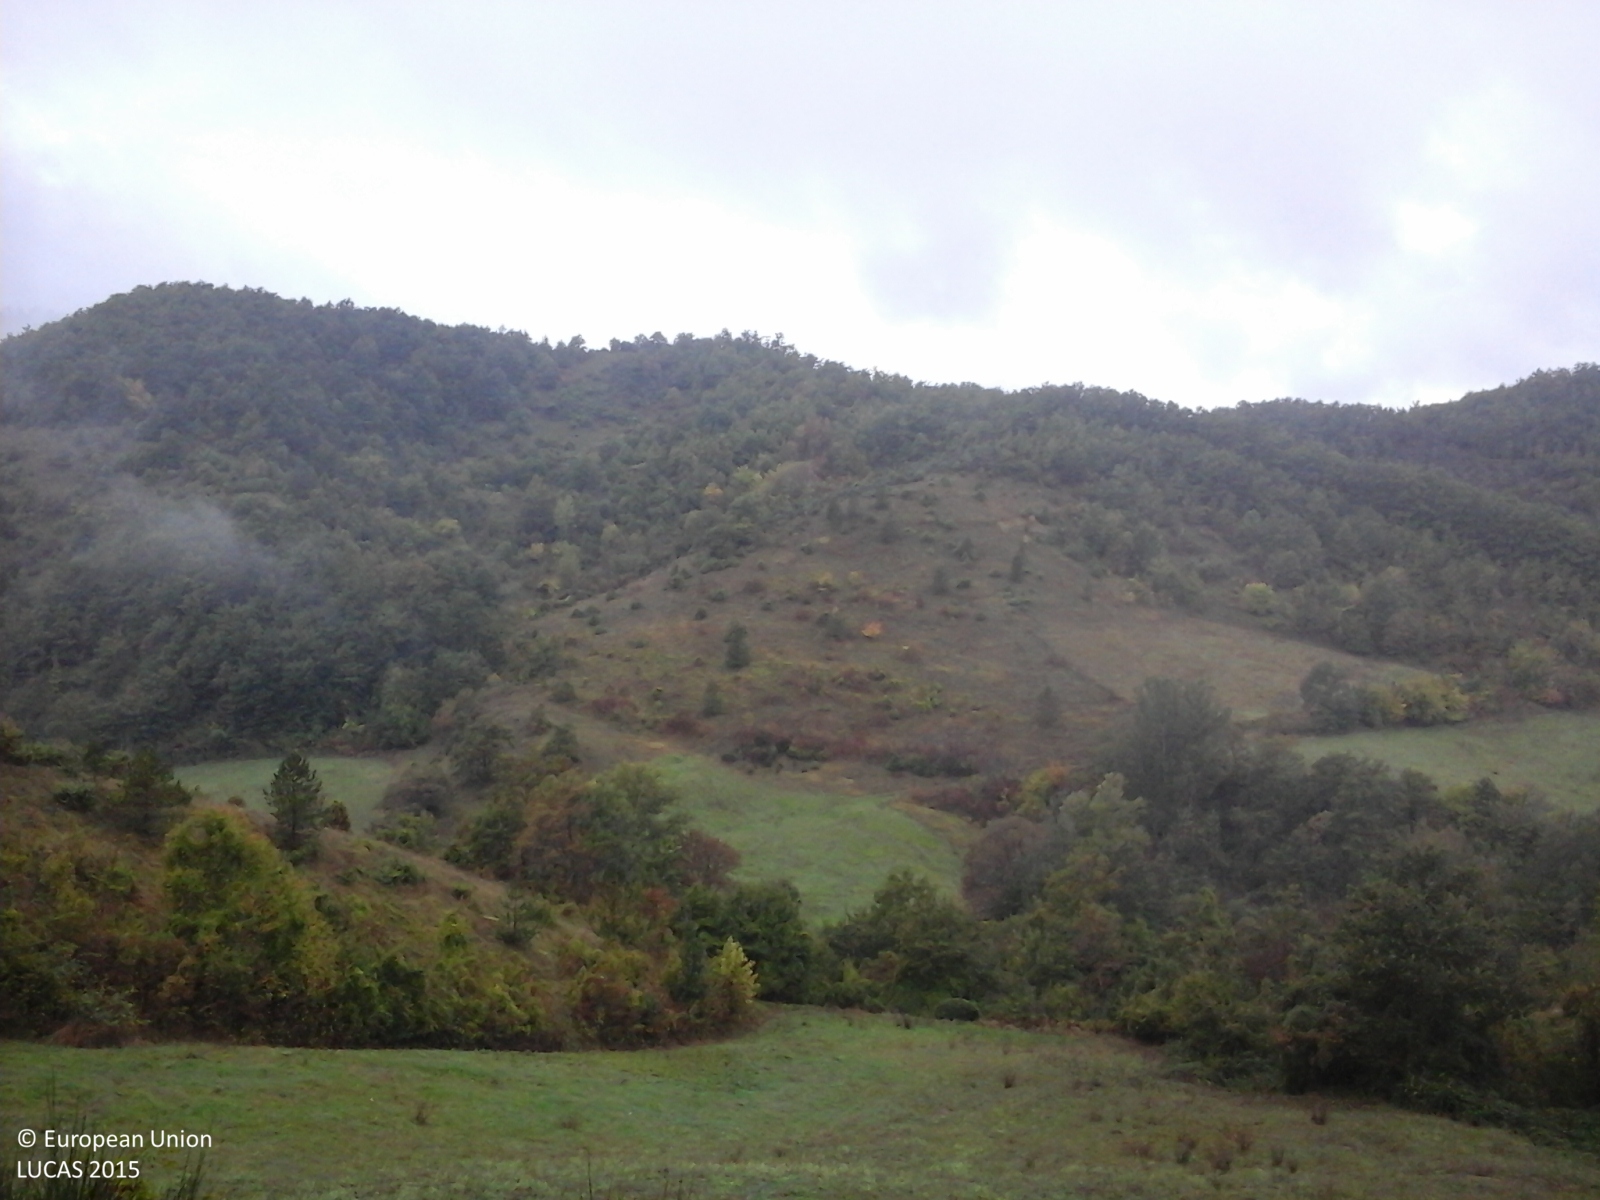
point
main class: Grassland
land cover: Grassland with sparse tree/shrub cover
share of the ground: > 75 %
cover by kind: herbaceous plants 90 %, broadleaved forest trees 5 %, shrubs 5 %
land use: Abandoned areas
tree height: > 5 m
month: October
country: IT
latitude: 43.4155
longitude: 12.5990
